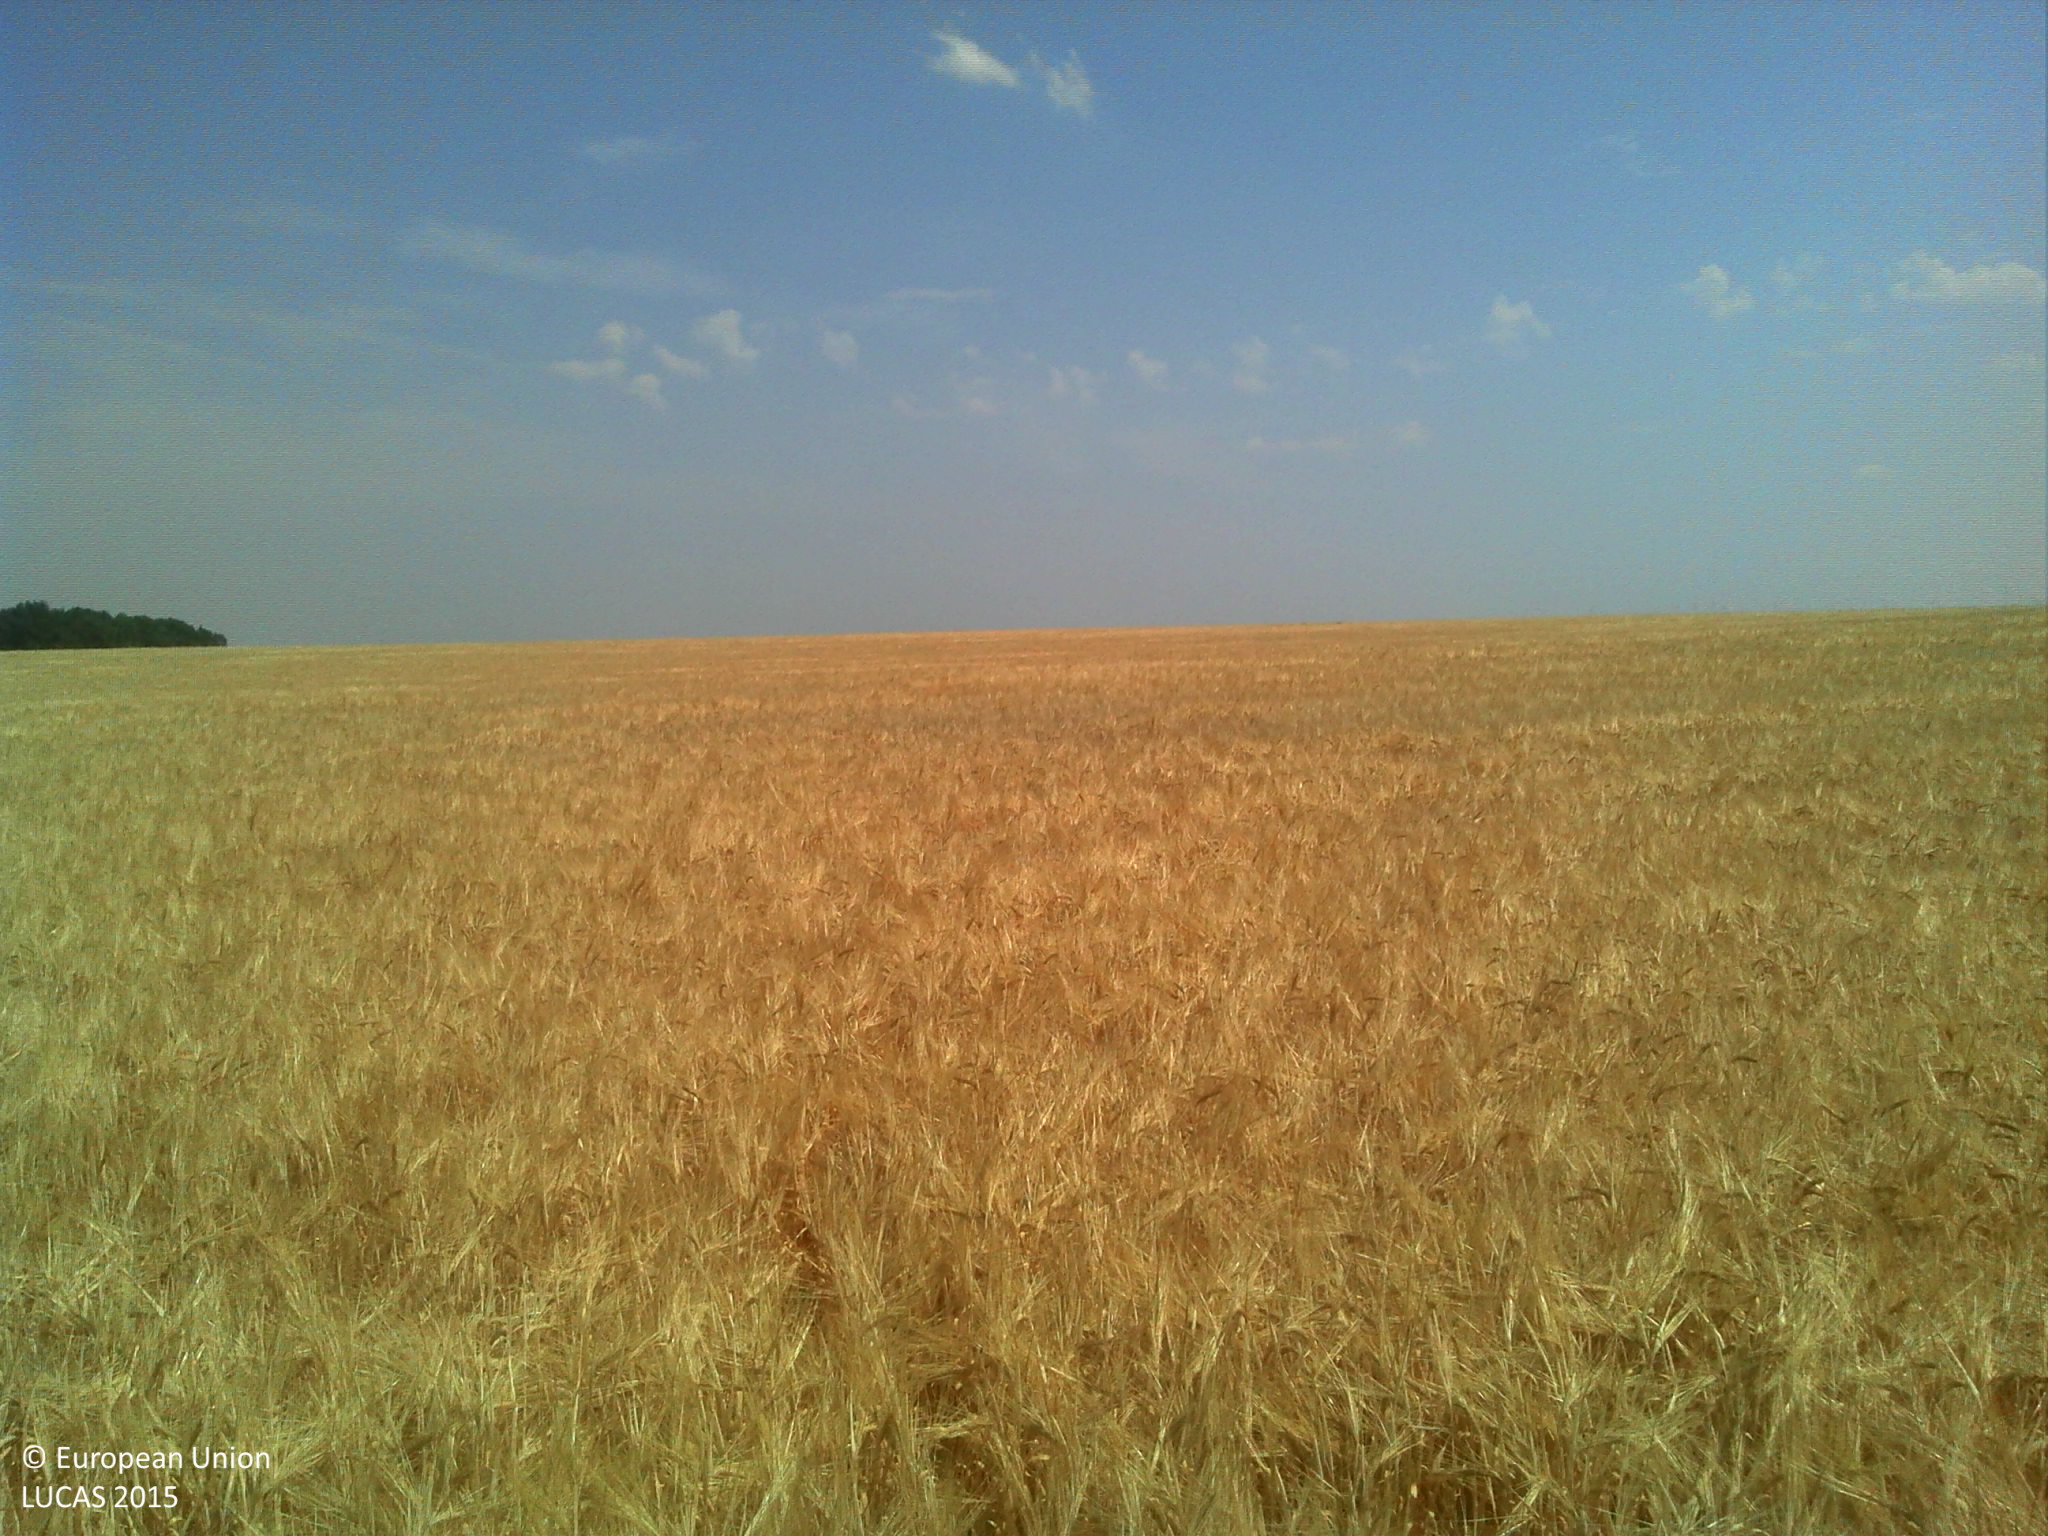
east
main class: Cropland
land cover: Barley
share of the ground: > 75 %
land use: Agriculture (excluding fallow land and kitchen gardens)
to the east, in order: Barley; Common wheat
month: July
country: FR
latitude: 47.9803
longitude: 4.9214
